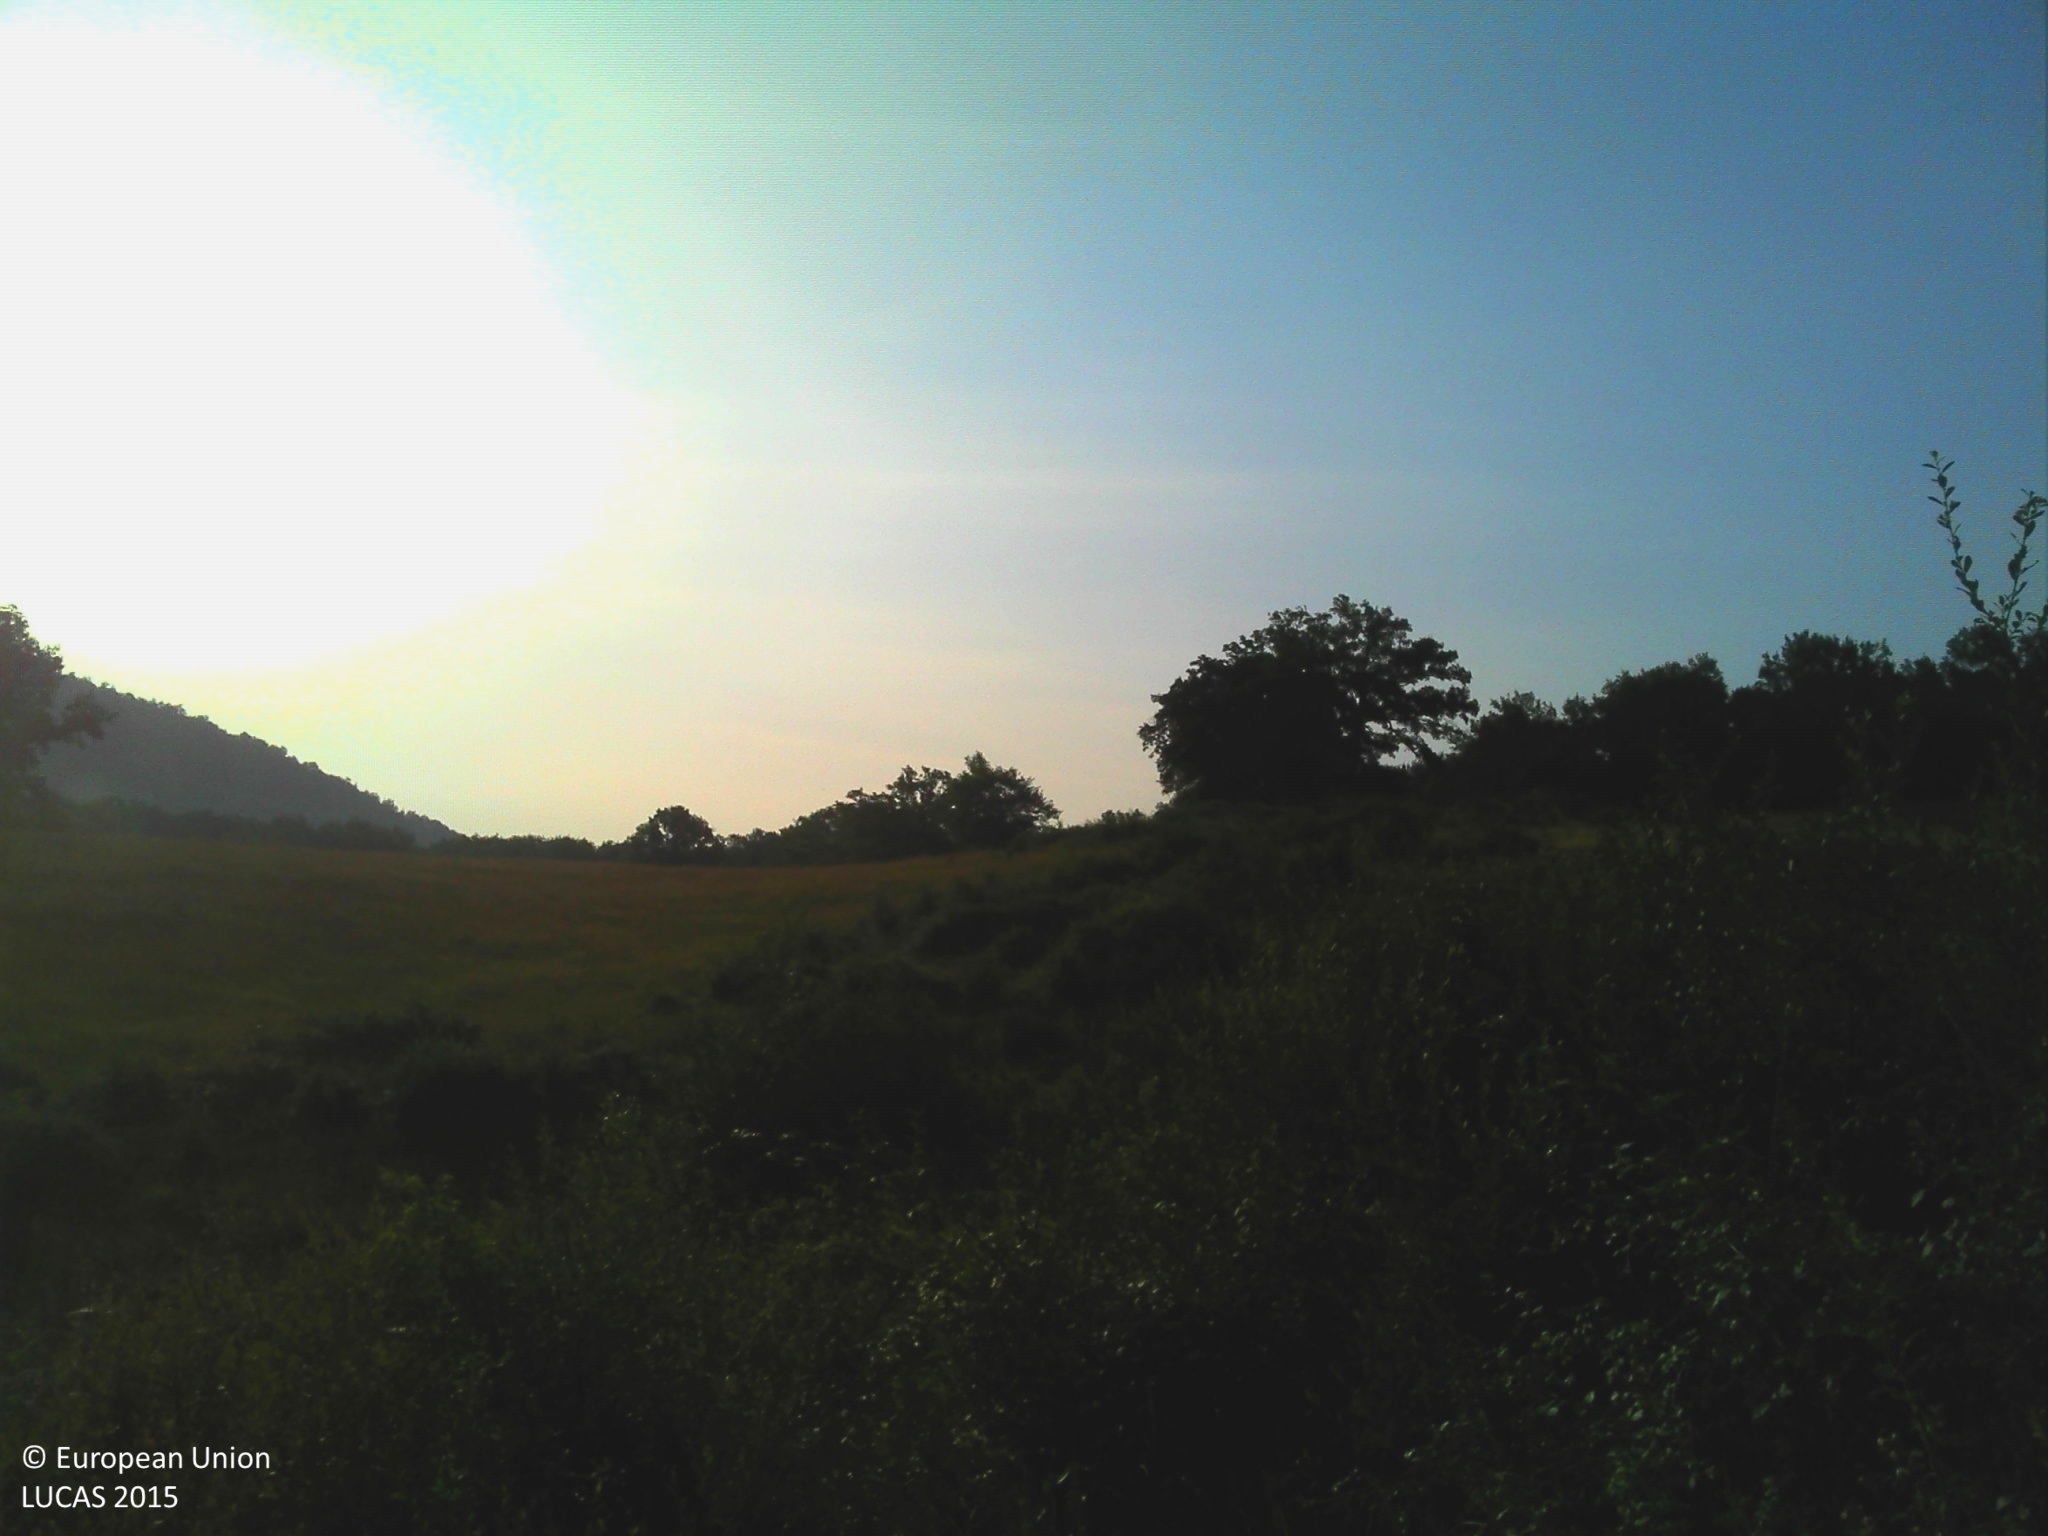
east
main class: Grassland
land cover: Spontaneously vegetated surfaces
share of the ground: > 75 %
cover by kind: herbaceous plants 100 %
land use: Semi-natural and natural areas not in use
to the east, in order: Spontaneously vegetated surfaces; Shrubland with sparse tree cover; Ditches and canals; Fences; Grassland with sparse tree/shrub cover; Spontaneously vegetated surfaces
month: July
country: FR
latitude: 43.1343
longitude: 1.1155
